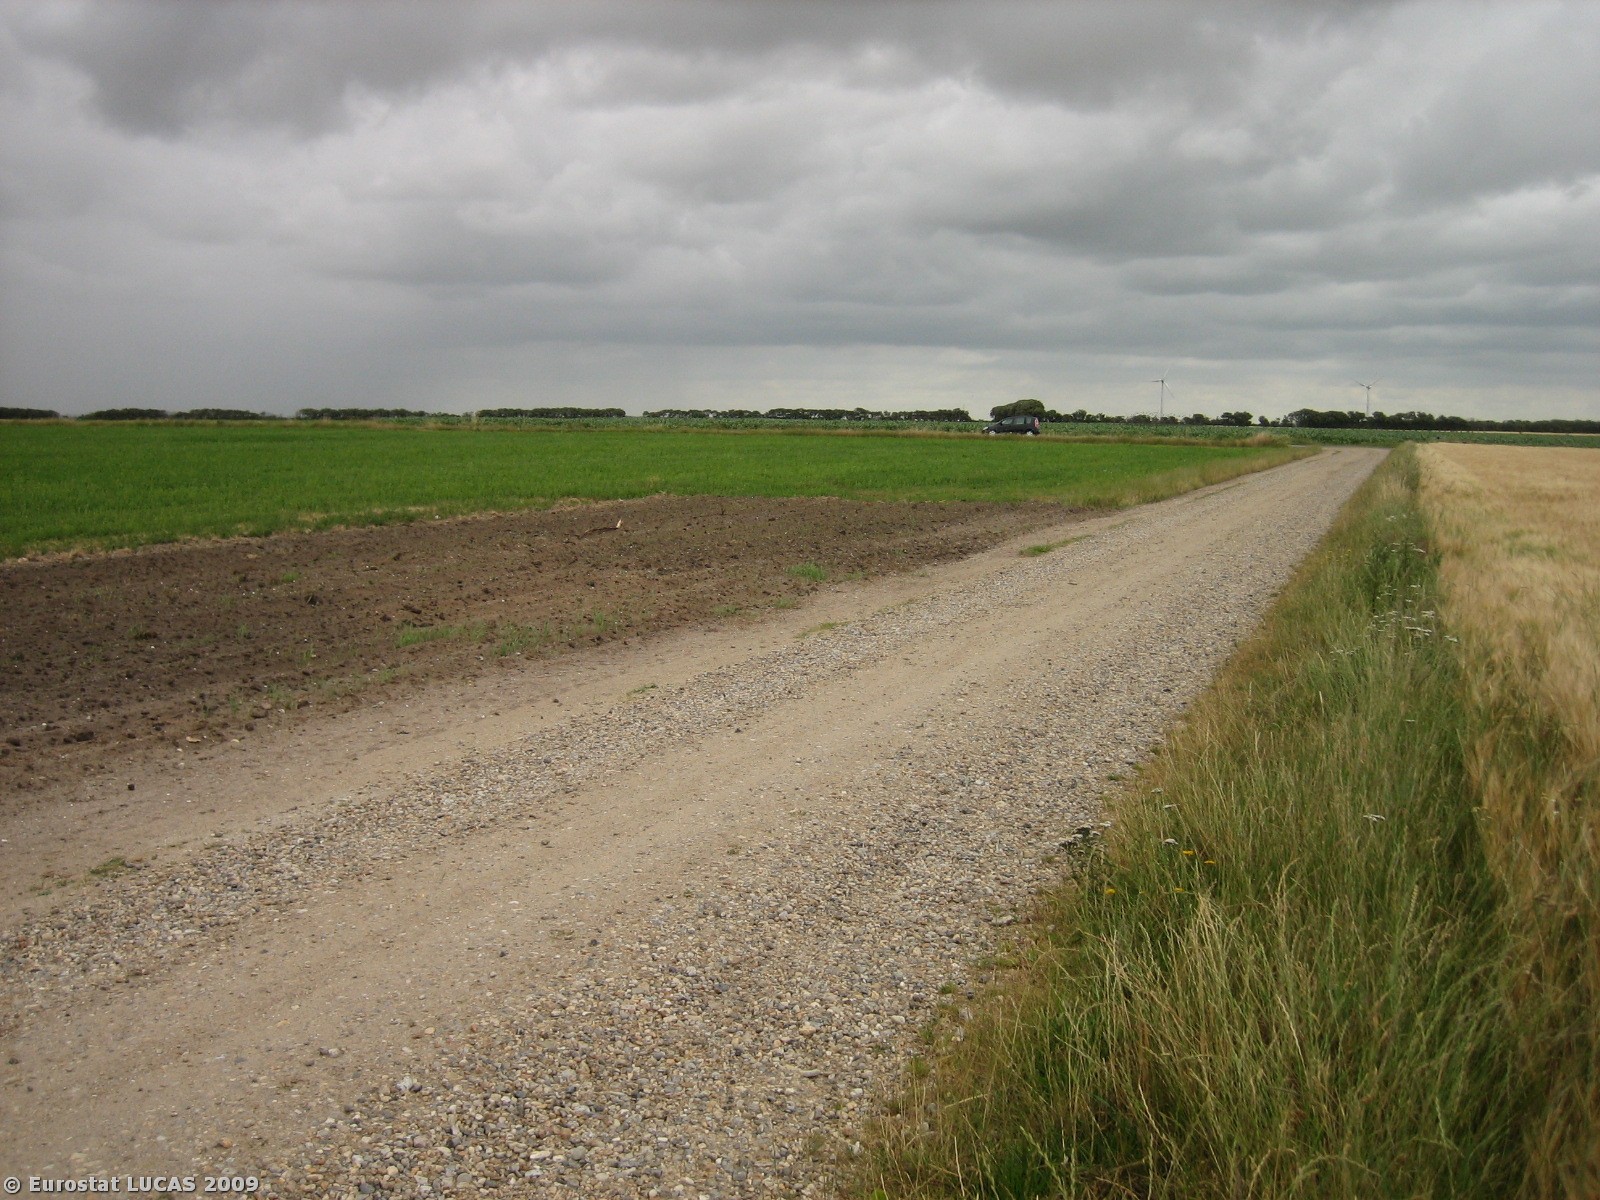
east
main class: Cropland
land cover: Barley
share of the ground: > 75 %
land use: Agriculture (excluding fallow land and kitchen gardens)
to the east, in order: Barley; Grass margins; Tracks; Bare land; Clovers; Grass margins; Paved roads, cycling and walking lanes; Grass margins; Maize; Grass margins; Clovers
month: July
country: DK
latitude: 55.6012
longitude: 8.3033
